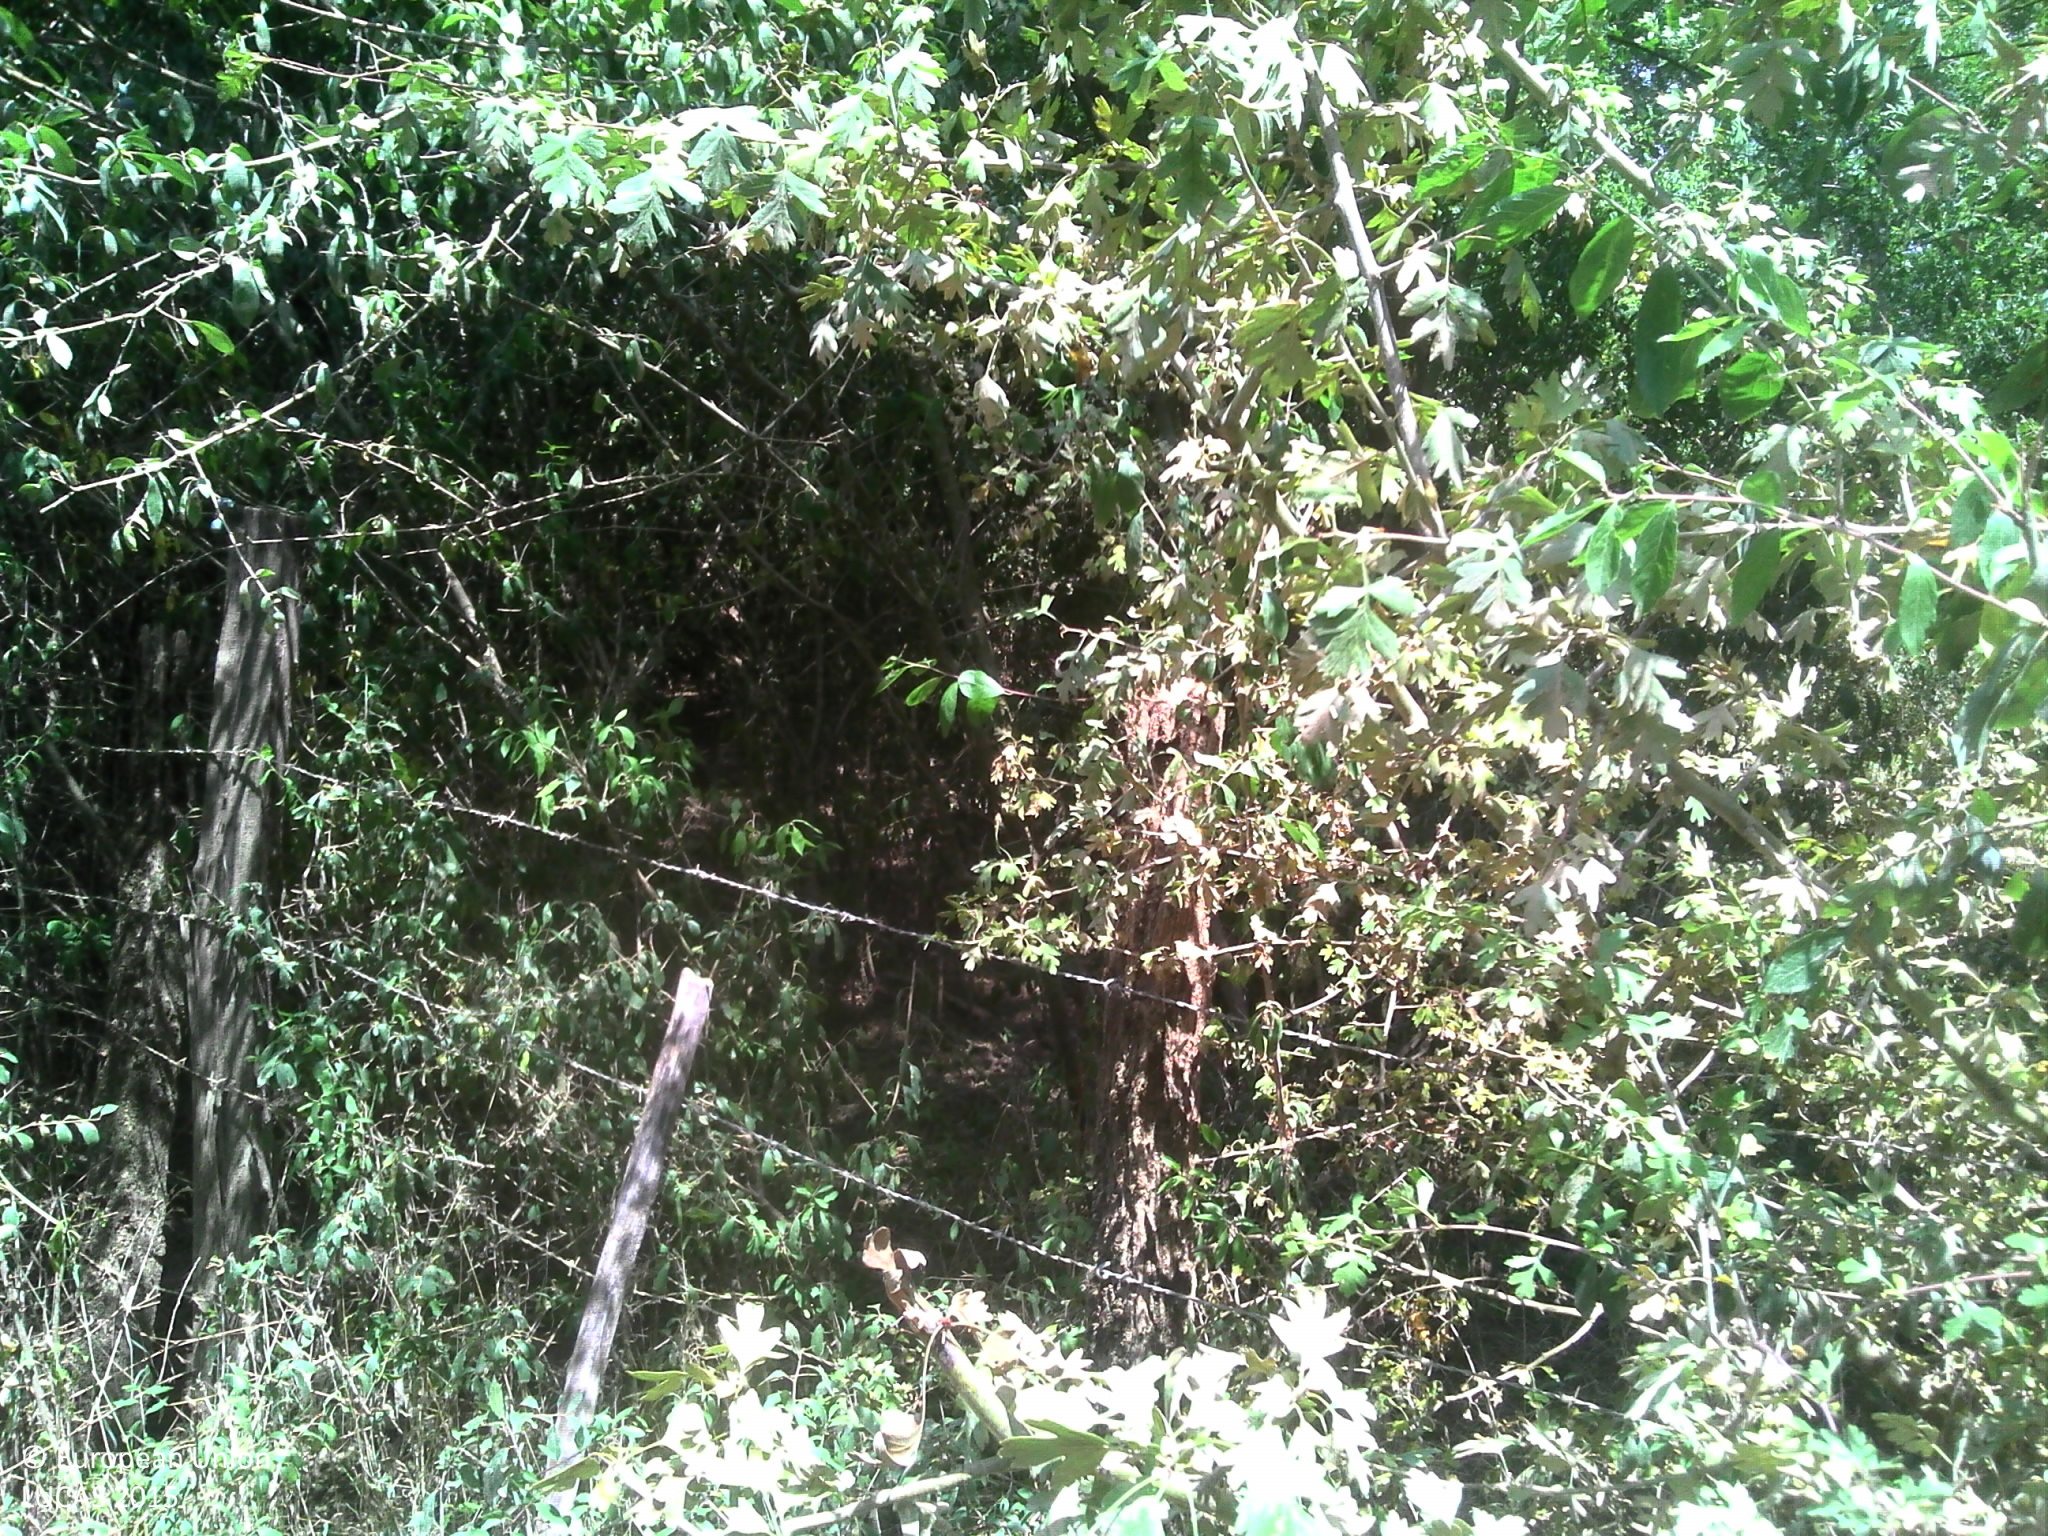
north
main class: Woodland
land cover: Broadleaved woodland
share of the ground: > 75 %
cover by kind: broadleaved forest trees 70 %, herbaceous plants 30 %
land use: Abandoned areas
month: July
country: FR
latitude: 46.9328
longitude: 5.2862
